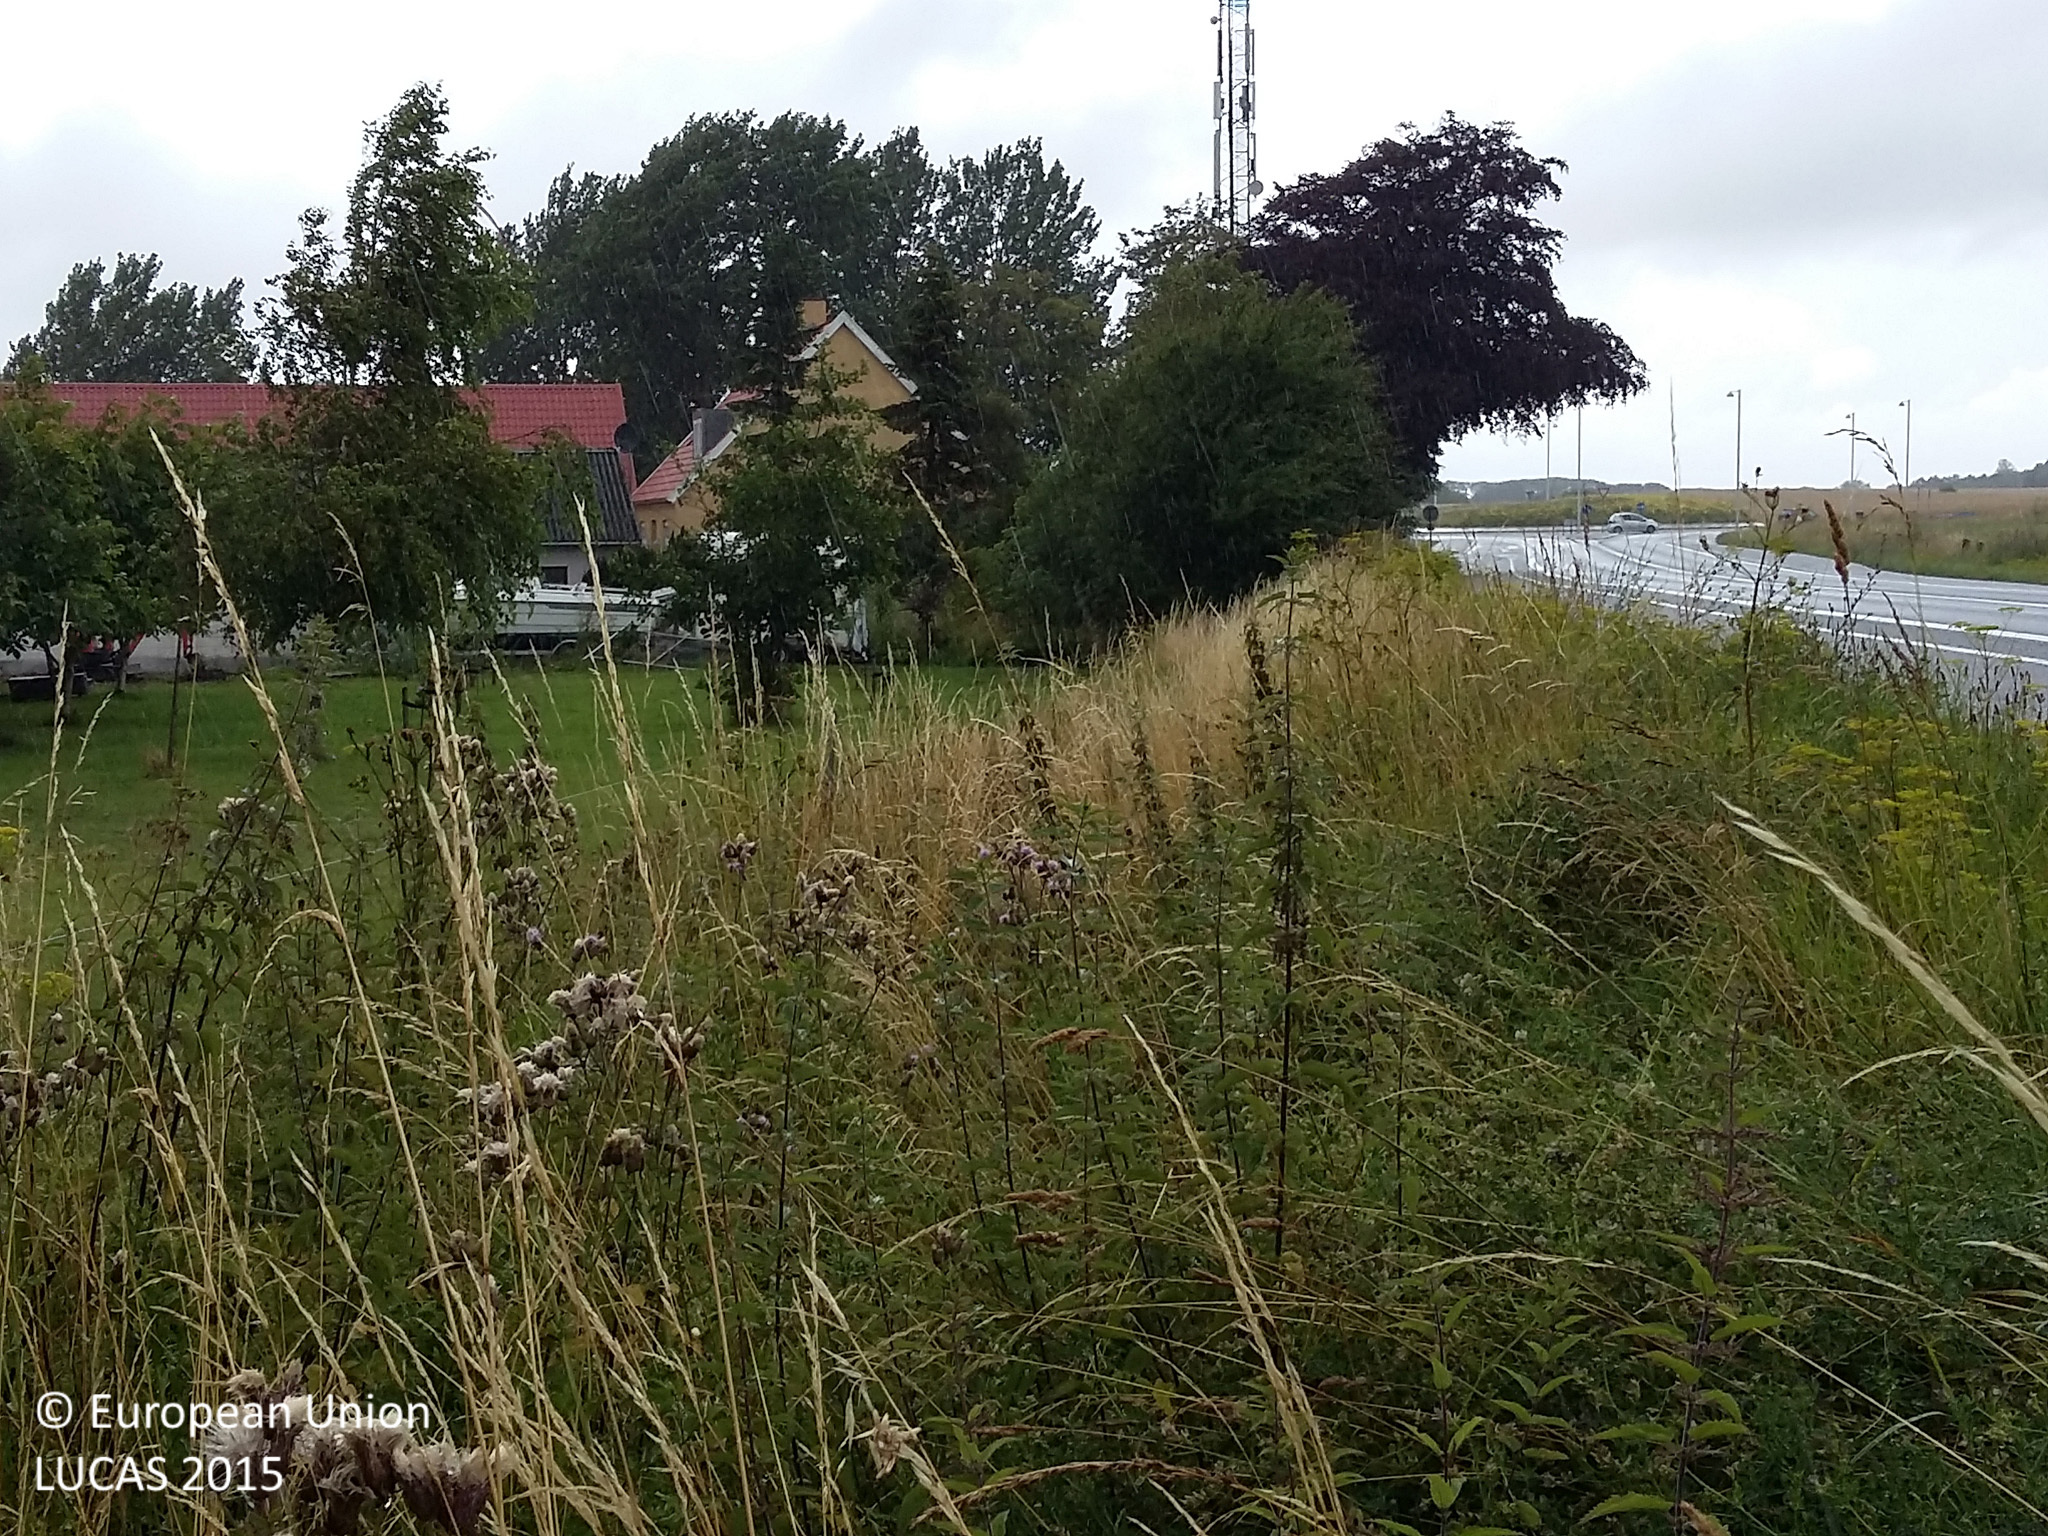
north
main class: Grassland
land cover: Spontaneously vegetated surfaces
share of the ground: > 75 %
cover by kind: herbaceous plants 100 %
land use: Semi-natural and natural areas not in use
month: July
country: DK
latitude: 55.9015
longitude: 12.0613
